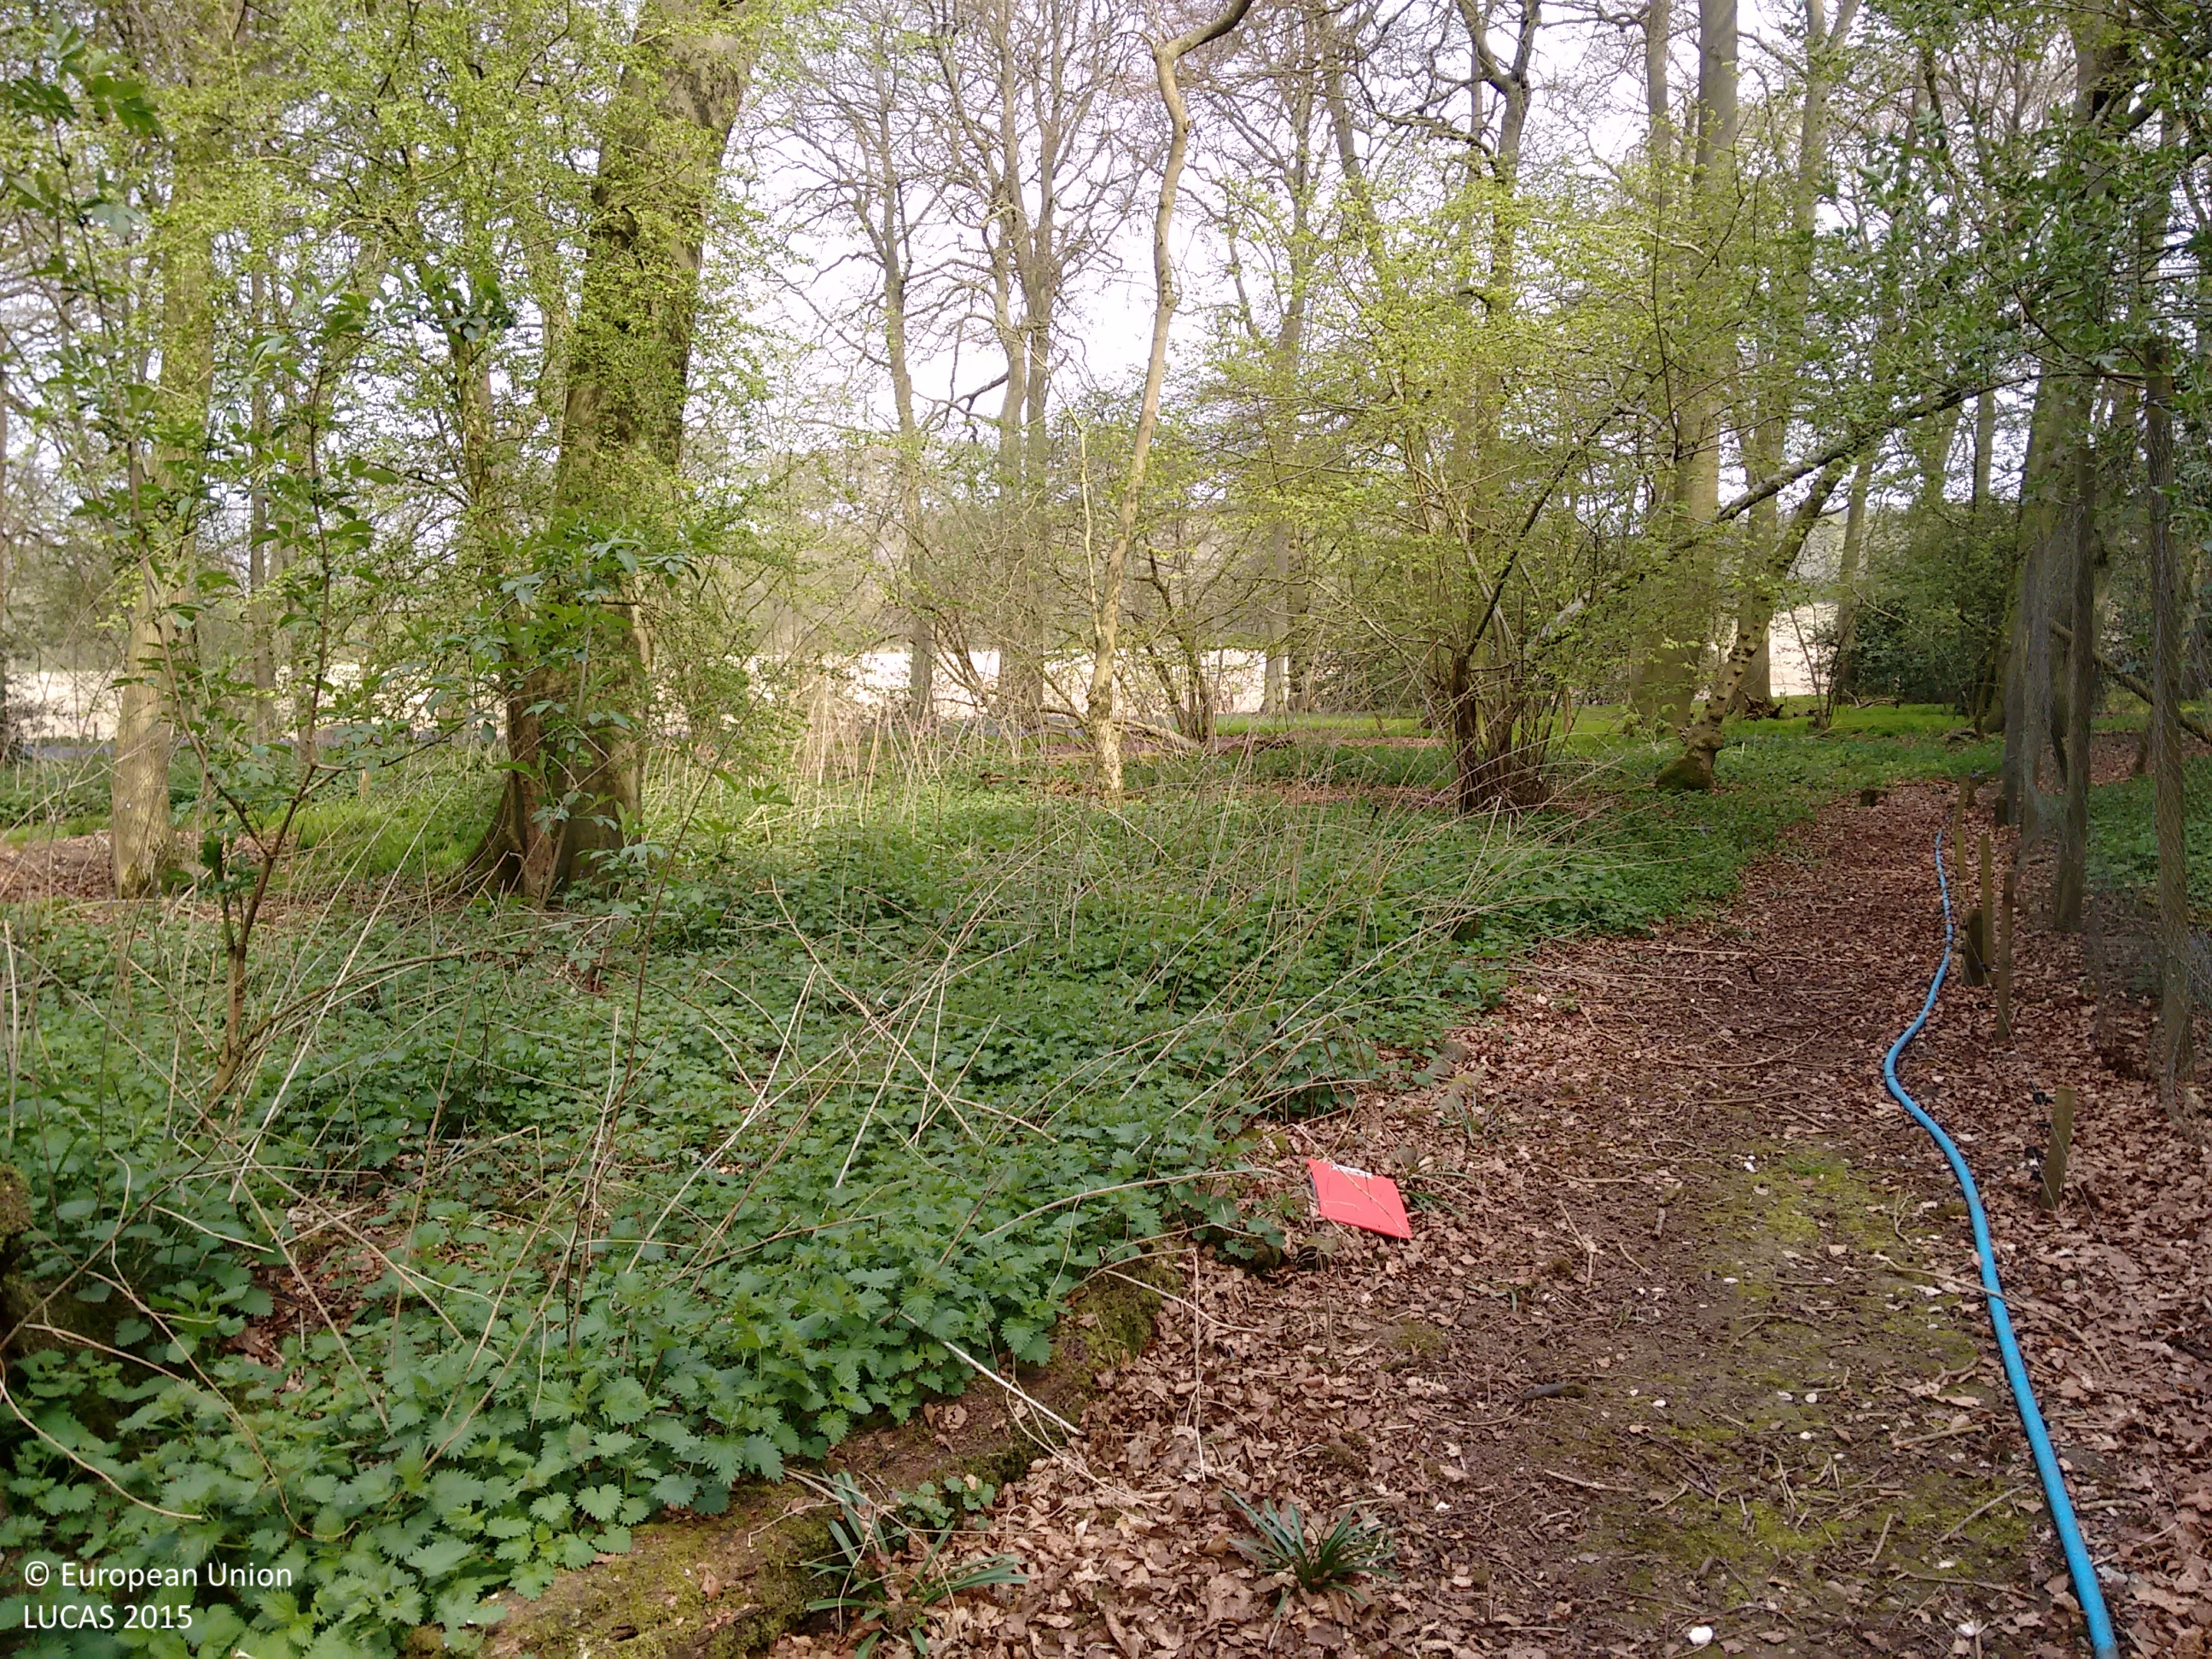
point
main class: Woodland
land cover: Broadleaved woodland
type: mesophytic deciduous forest
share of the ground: > 75 %
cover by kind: broadleaved forest trees 100 %
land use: Forestry
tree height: > 5 m
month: April
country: GB
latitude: 51.7228
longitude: -0.7686
